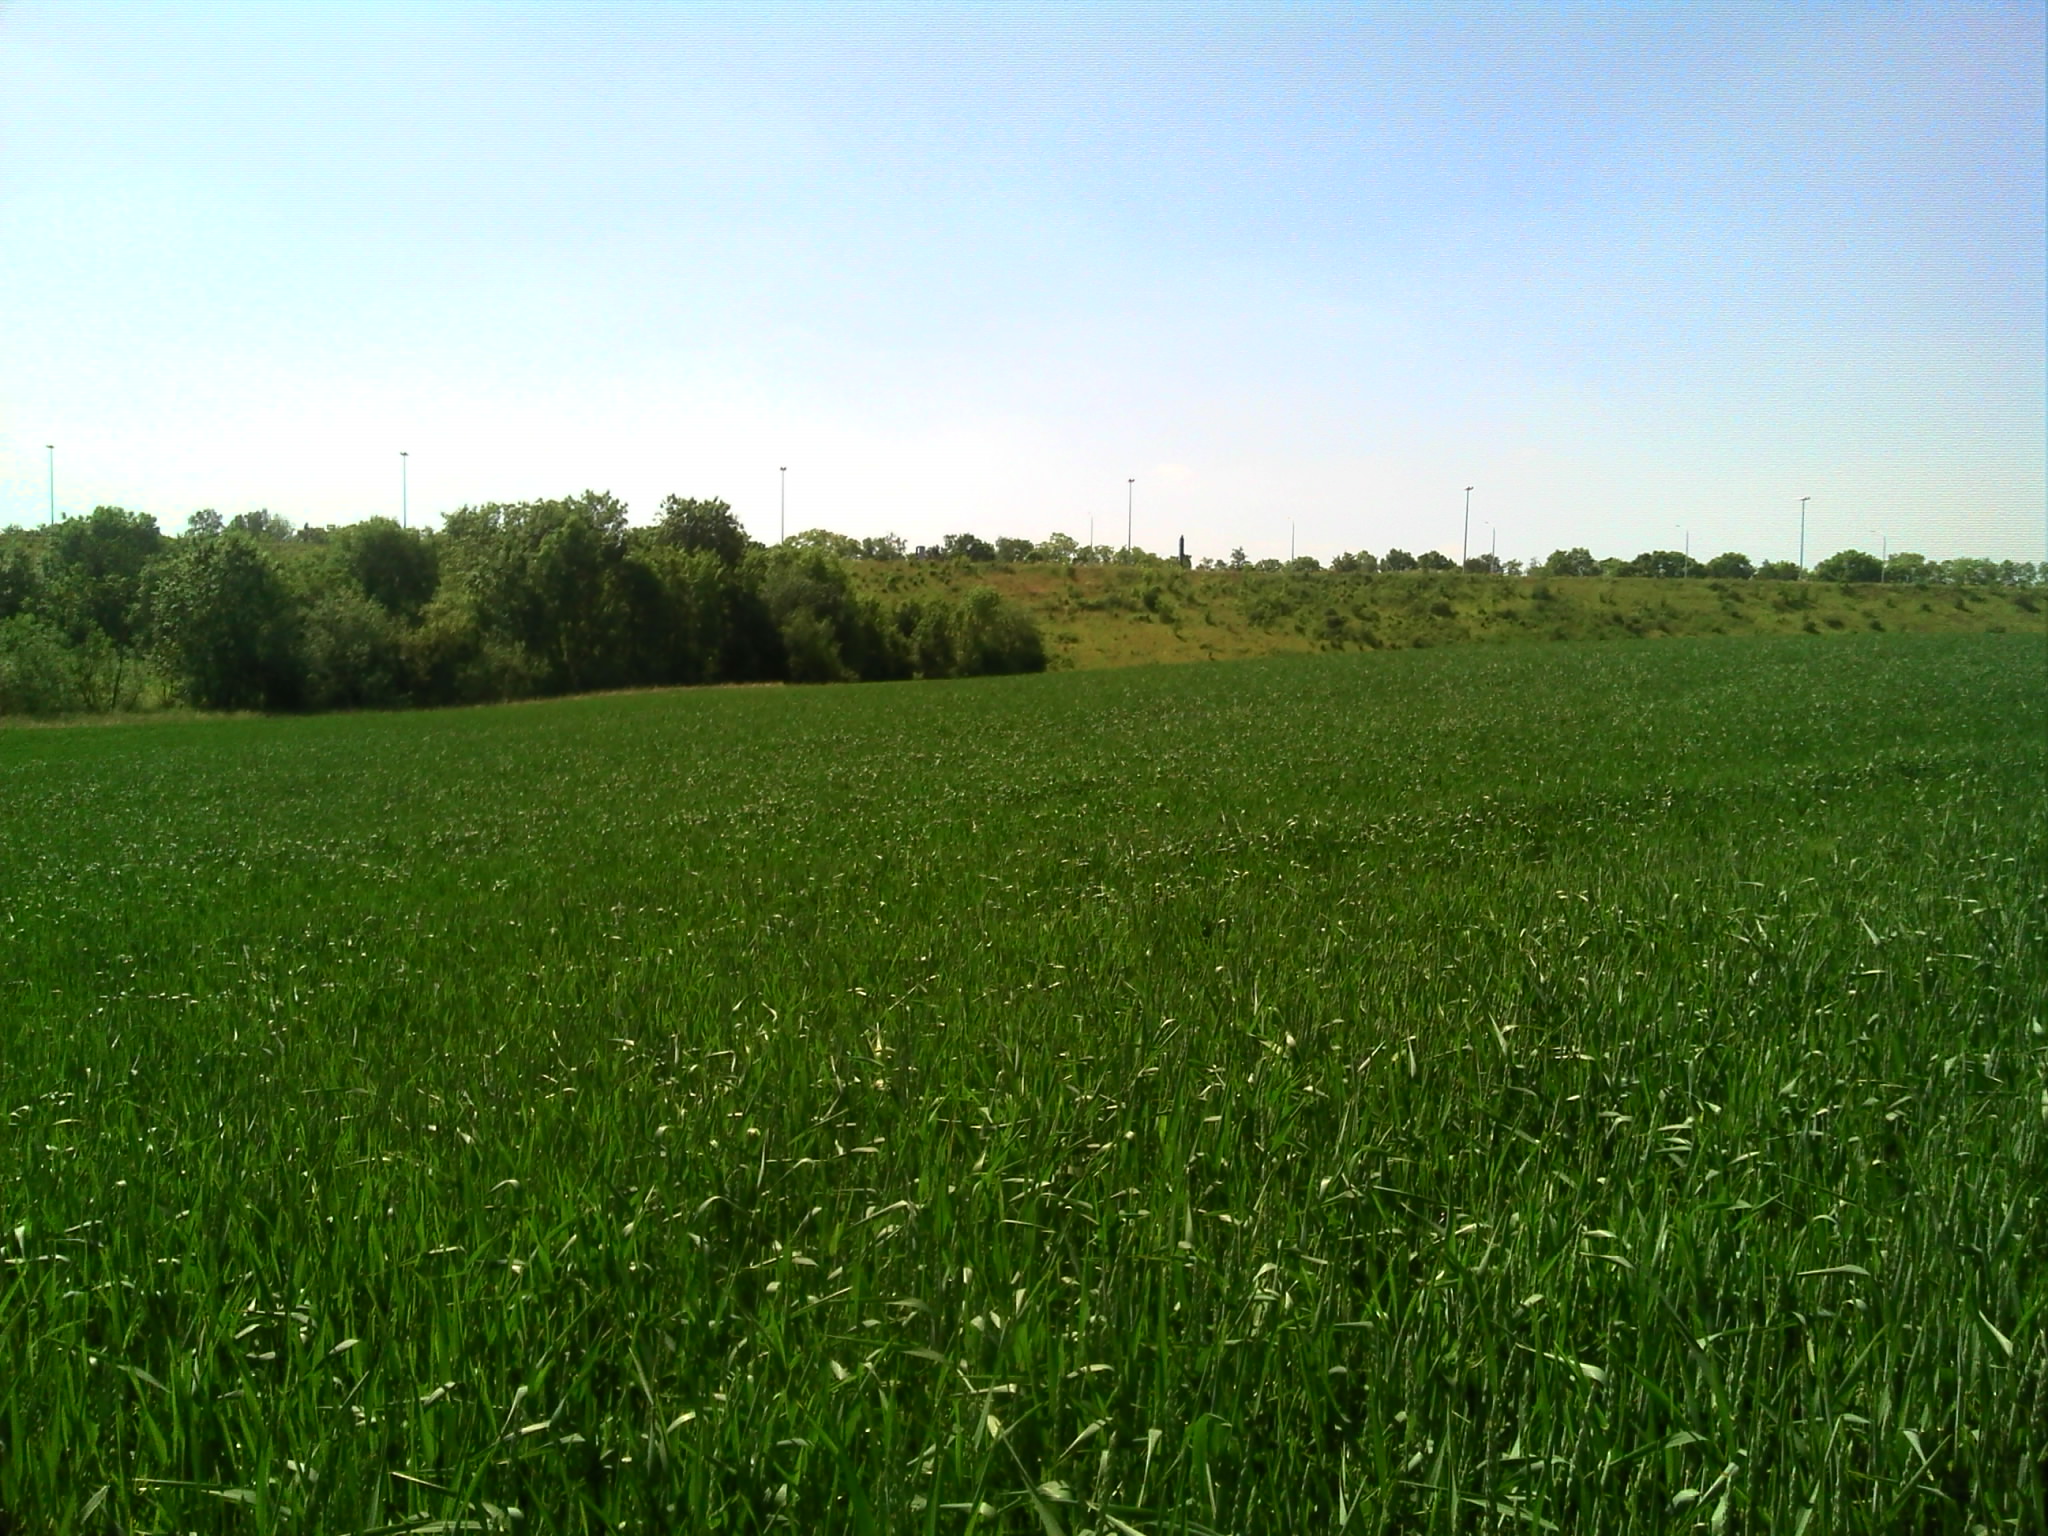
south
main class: Cropland
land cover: Common wheat
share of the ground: > 75 %
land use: Agriculture (excluding fallow land and kitchen gardens)
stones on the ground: < 10 %
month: June
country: BE
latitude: 50.4978
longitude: 4.7946
